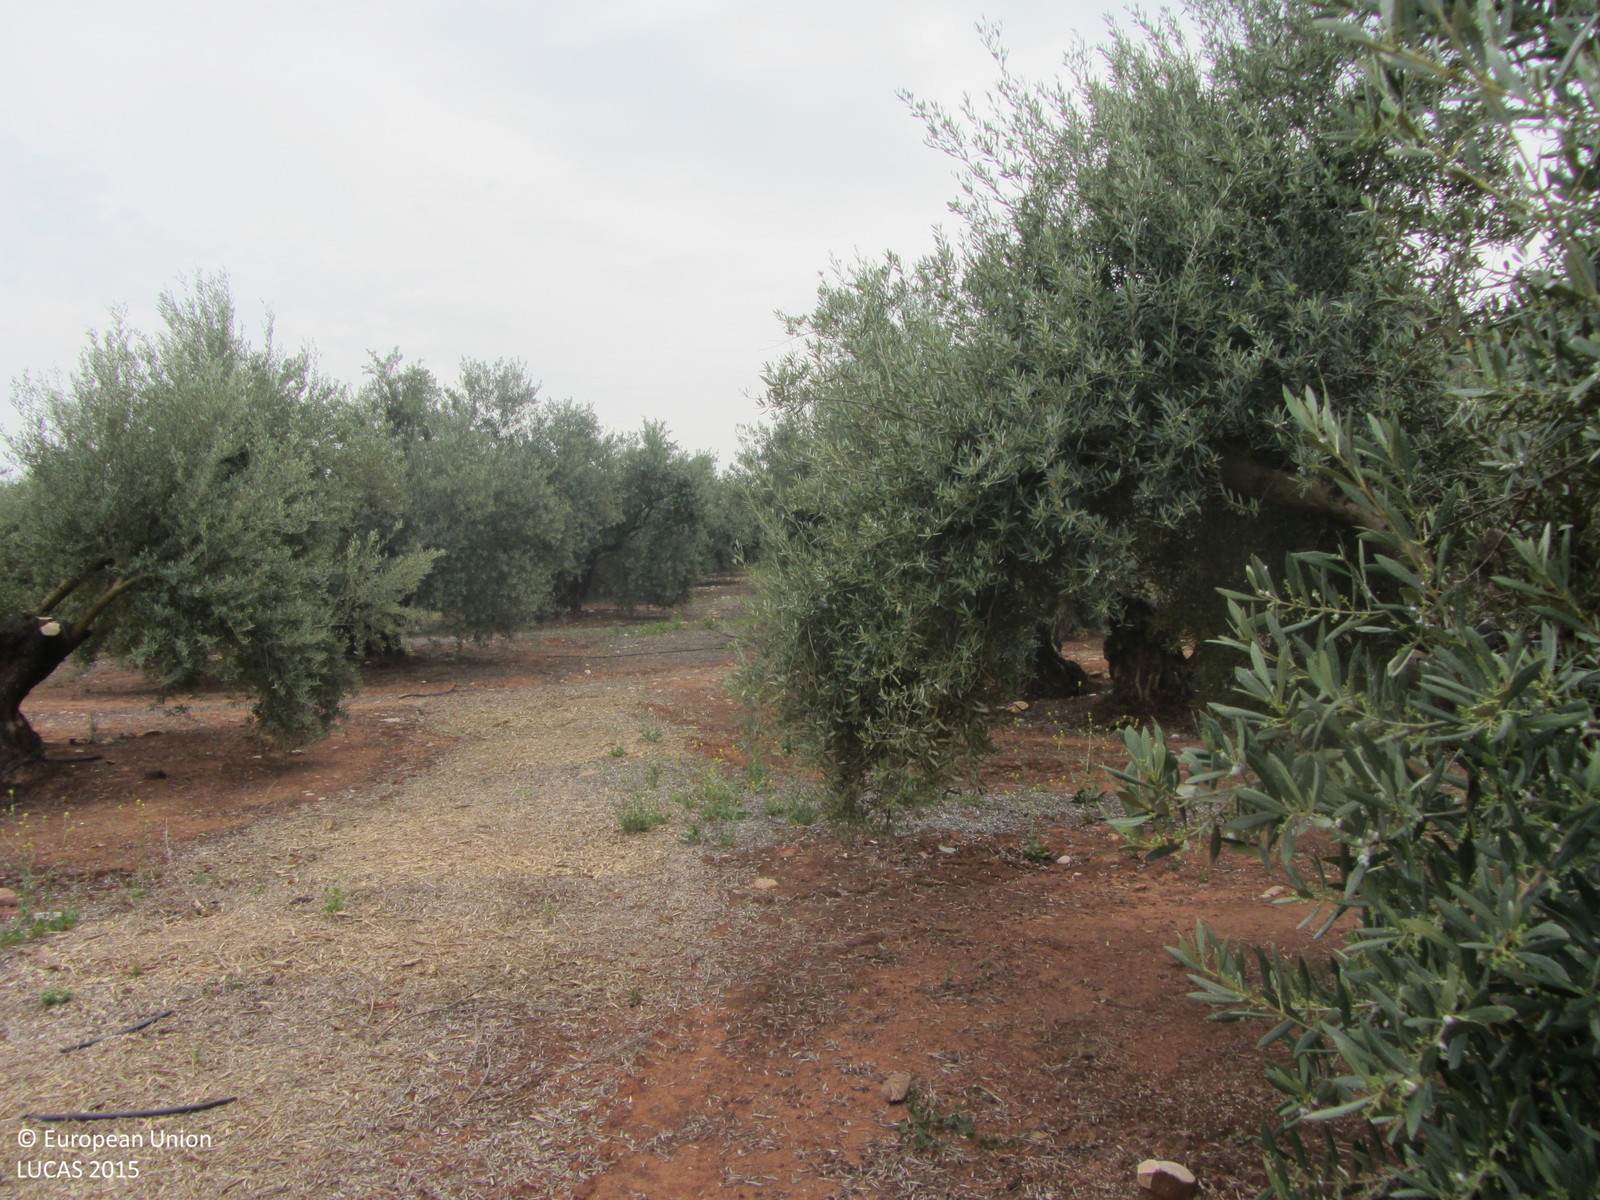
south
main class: Cropland
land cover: Olive groves
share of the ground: 25 - 50 %
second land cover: Other bare soil
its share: > 75 %
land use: Agriculture (excluding fallow land and kitchen gardens)
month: May
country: ES
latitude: 38.2427
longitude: -3.0139
